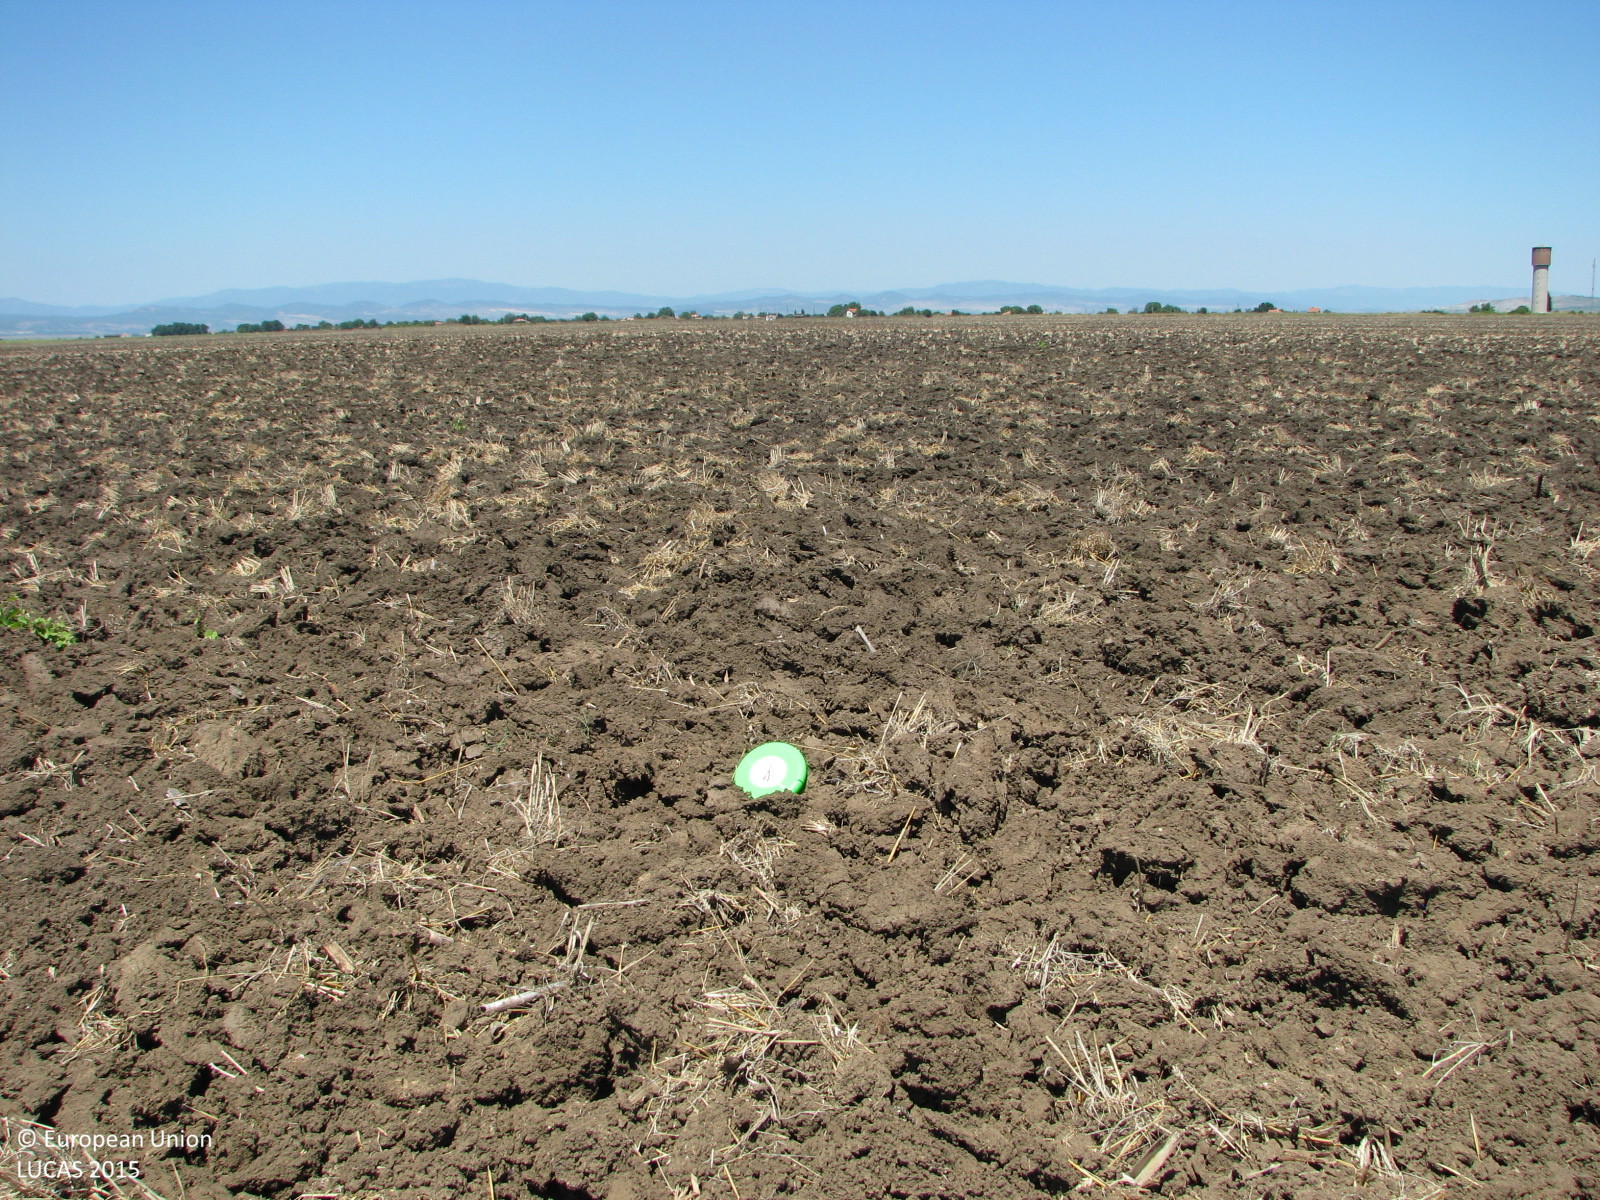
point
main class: Cropland
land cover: Common wheat
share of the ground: < 10 %
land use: Agriculture (excluding fallow land and kitchen gardens)
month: July
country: BG
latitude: 42.3550
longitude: 25.9455
